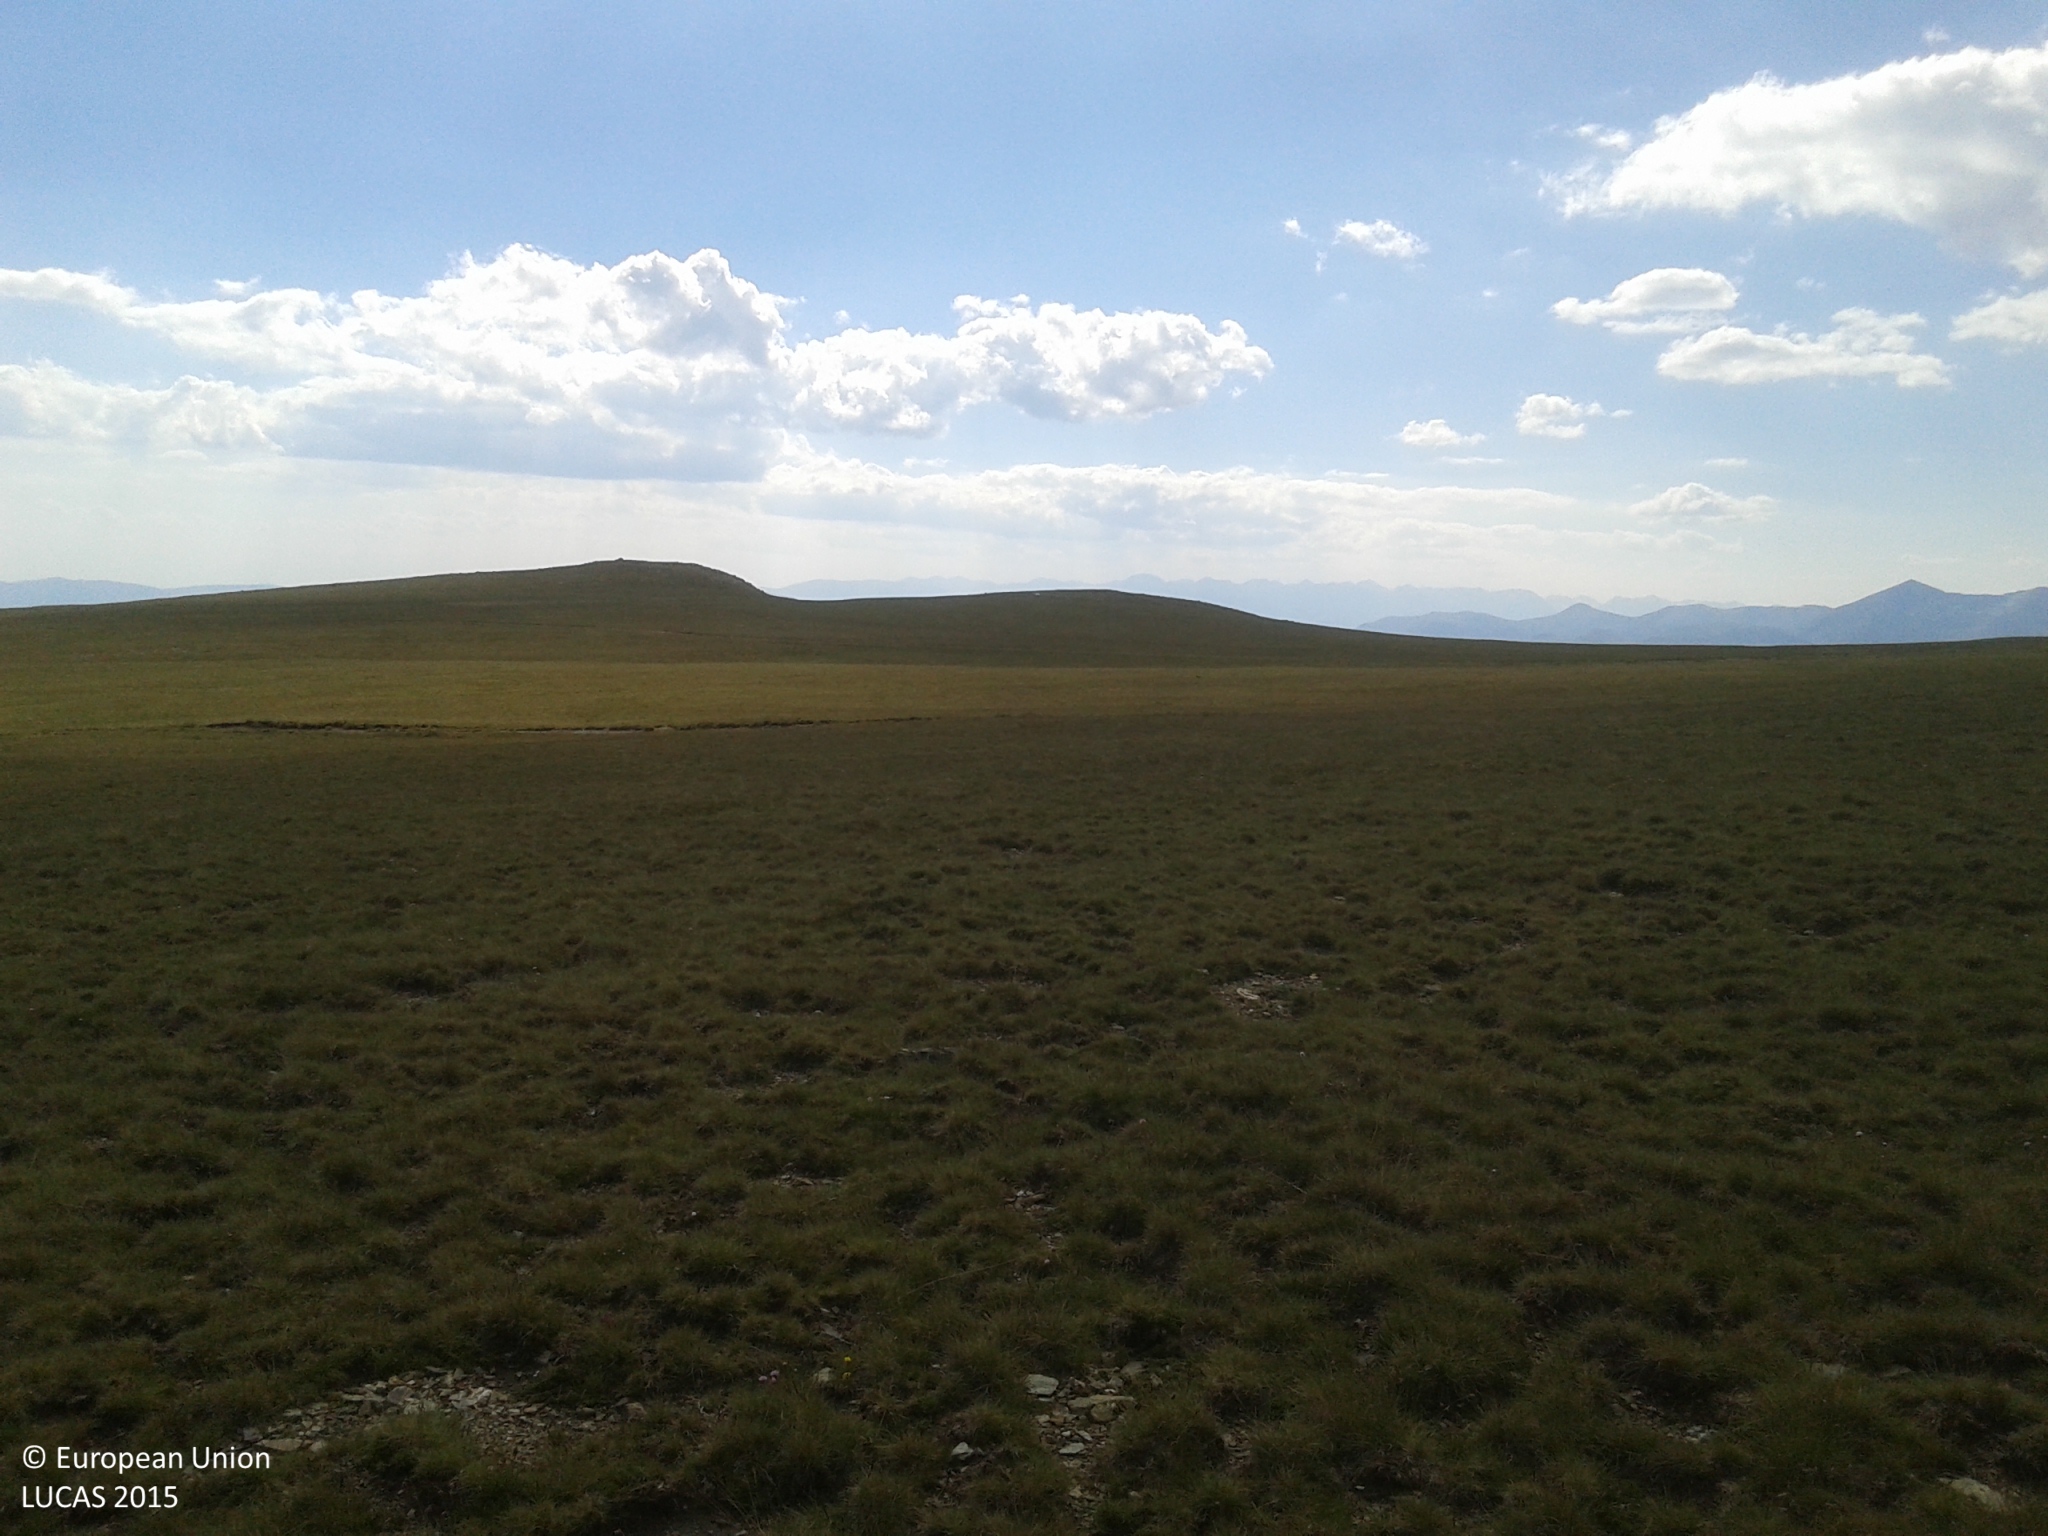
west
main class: Grassland
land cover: Grassland without tree/shrub cover
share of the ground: > 75 %
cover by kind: herbaceous plants 90 %, consolidated bare surface 10 %
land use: Agriculture (excluding fallow land and kitchen gardens)
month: June
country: ES
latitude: 42.4464
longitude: 1.5599
